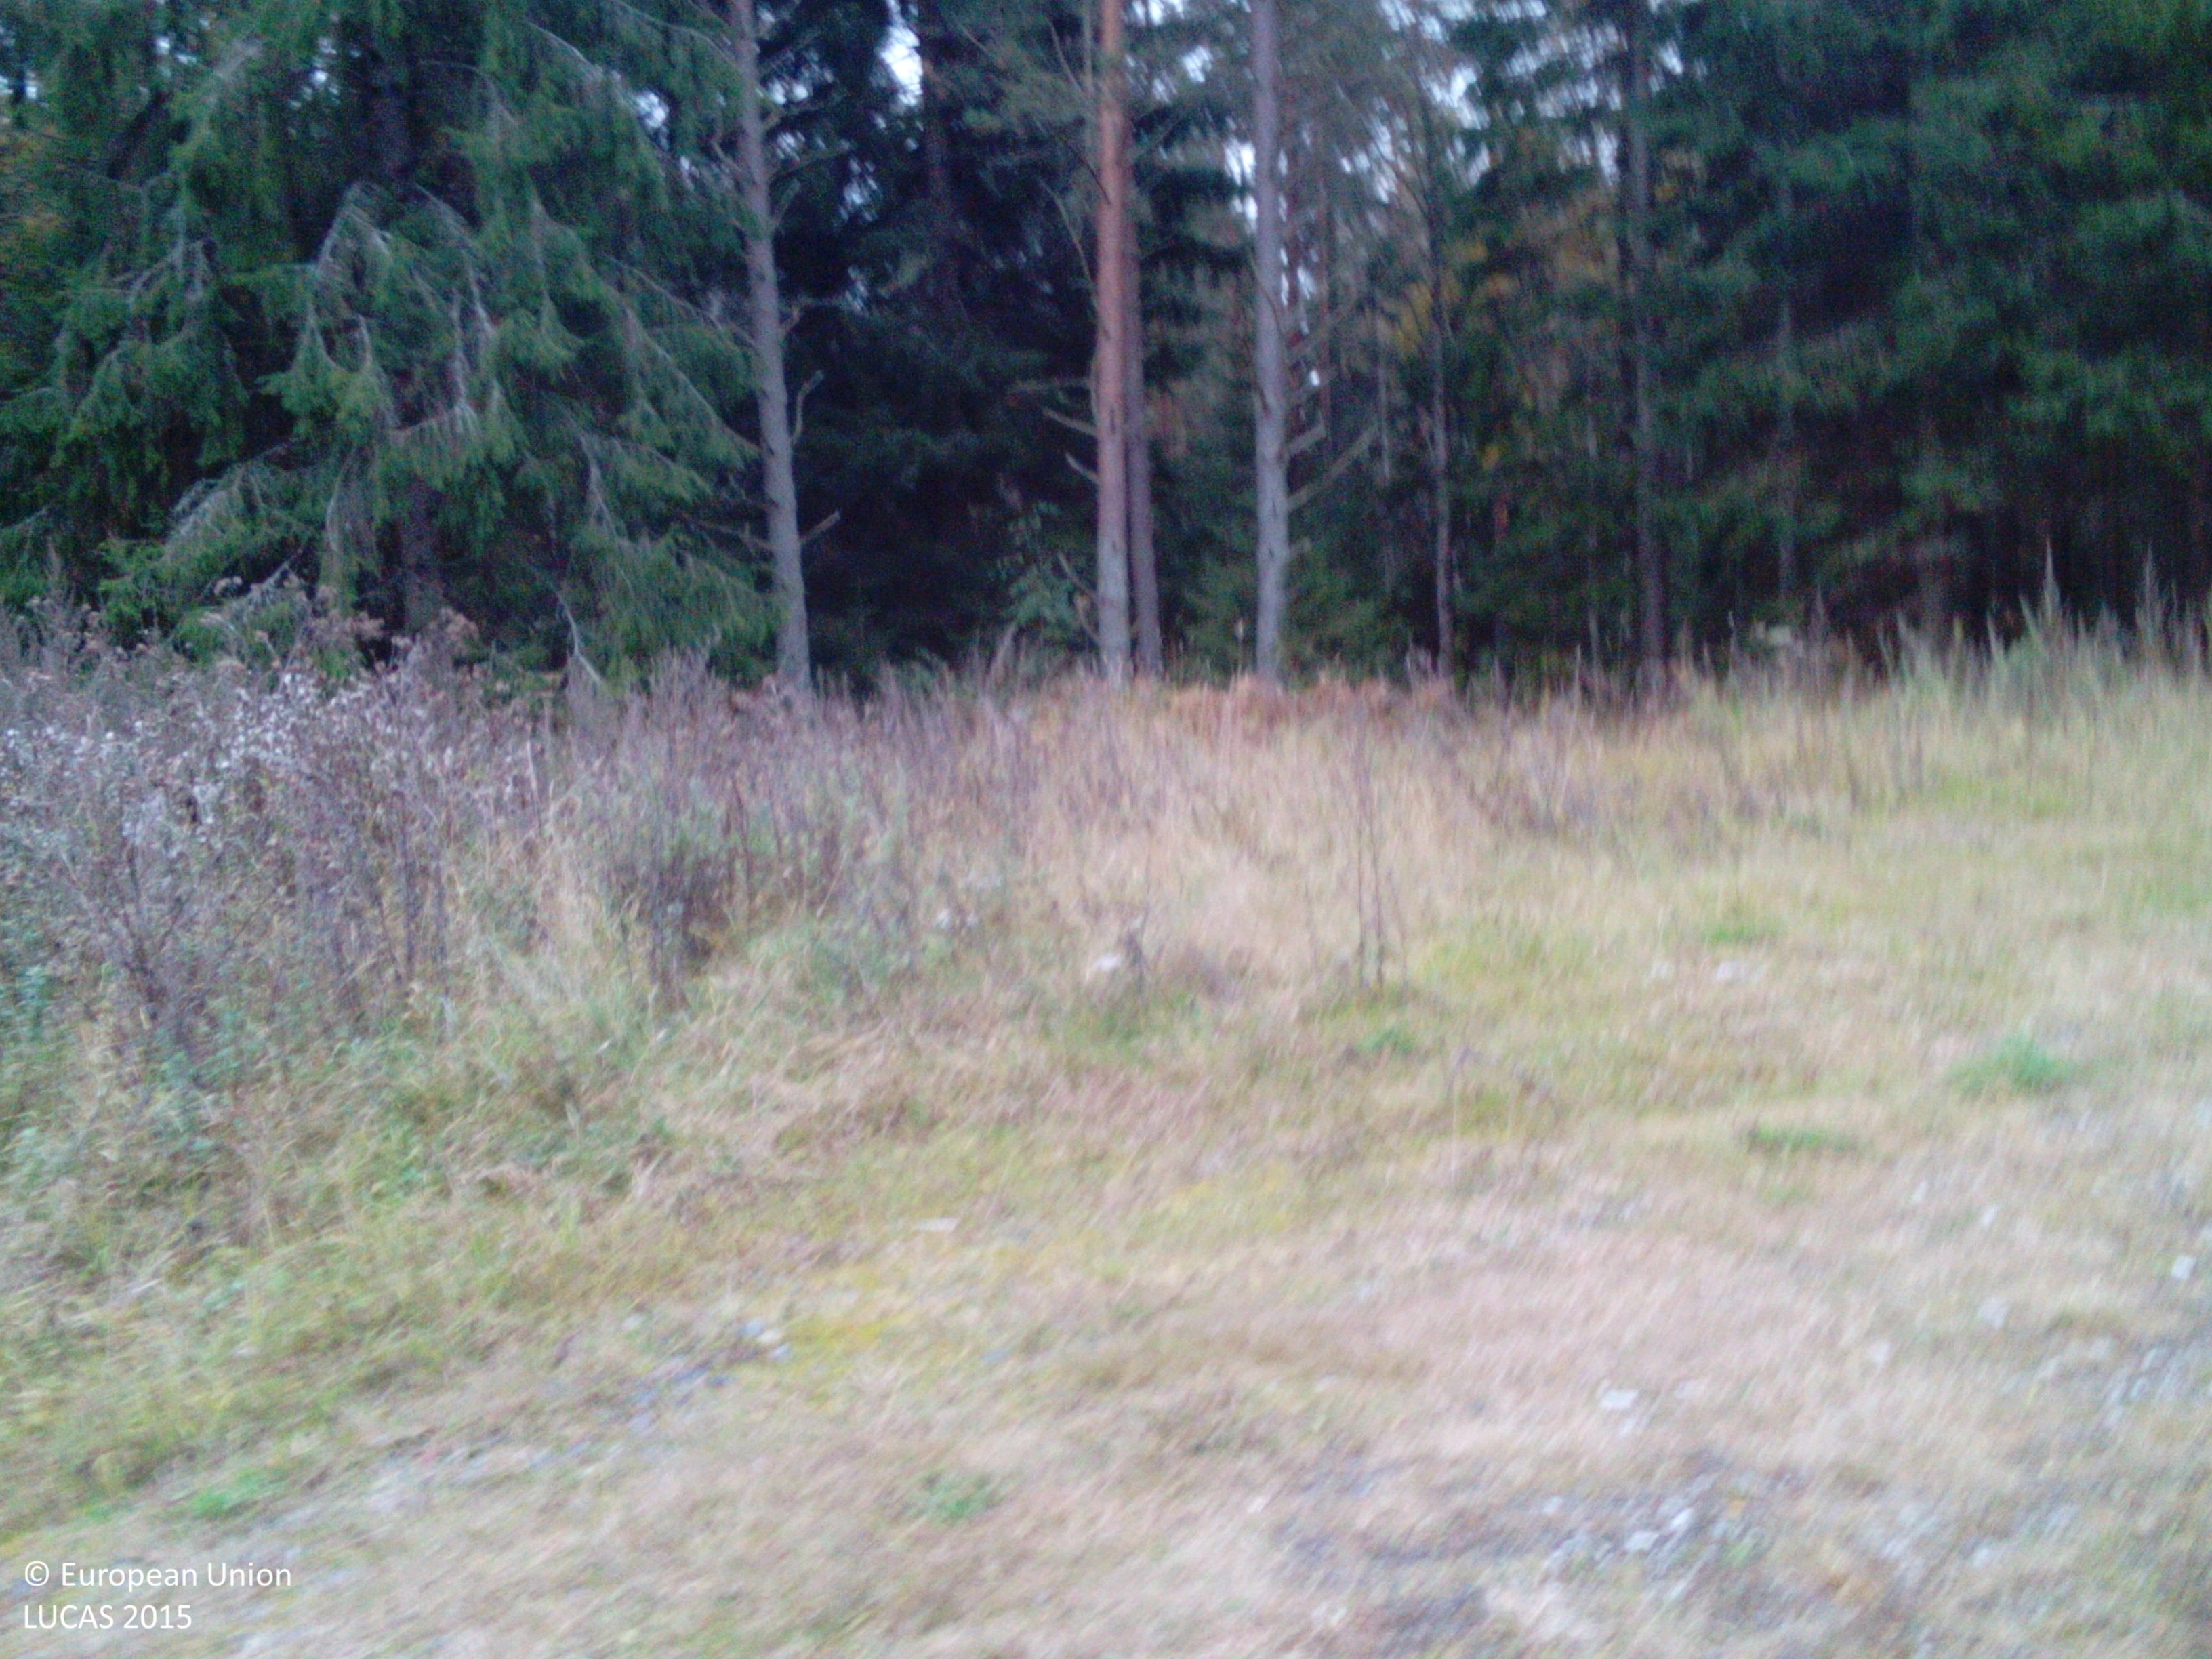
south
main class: Grassland
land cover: Grassland without tree/shrub cover
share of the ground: > 75 %
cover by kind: herbaceous plants 100 %
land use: Semi-natural and natural areas not in use
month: October
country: SE
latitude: 58.8081
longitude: 16.3826
